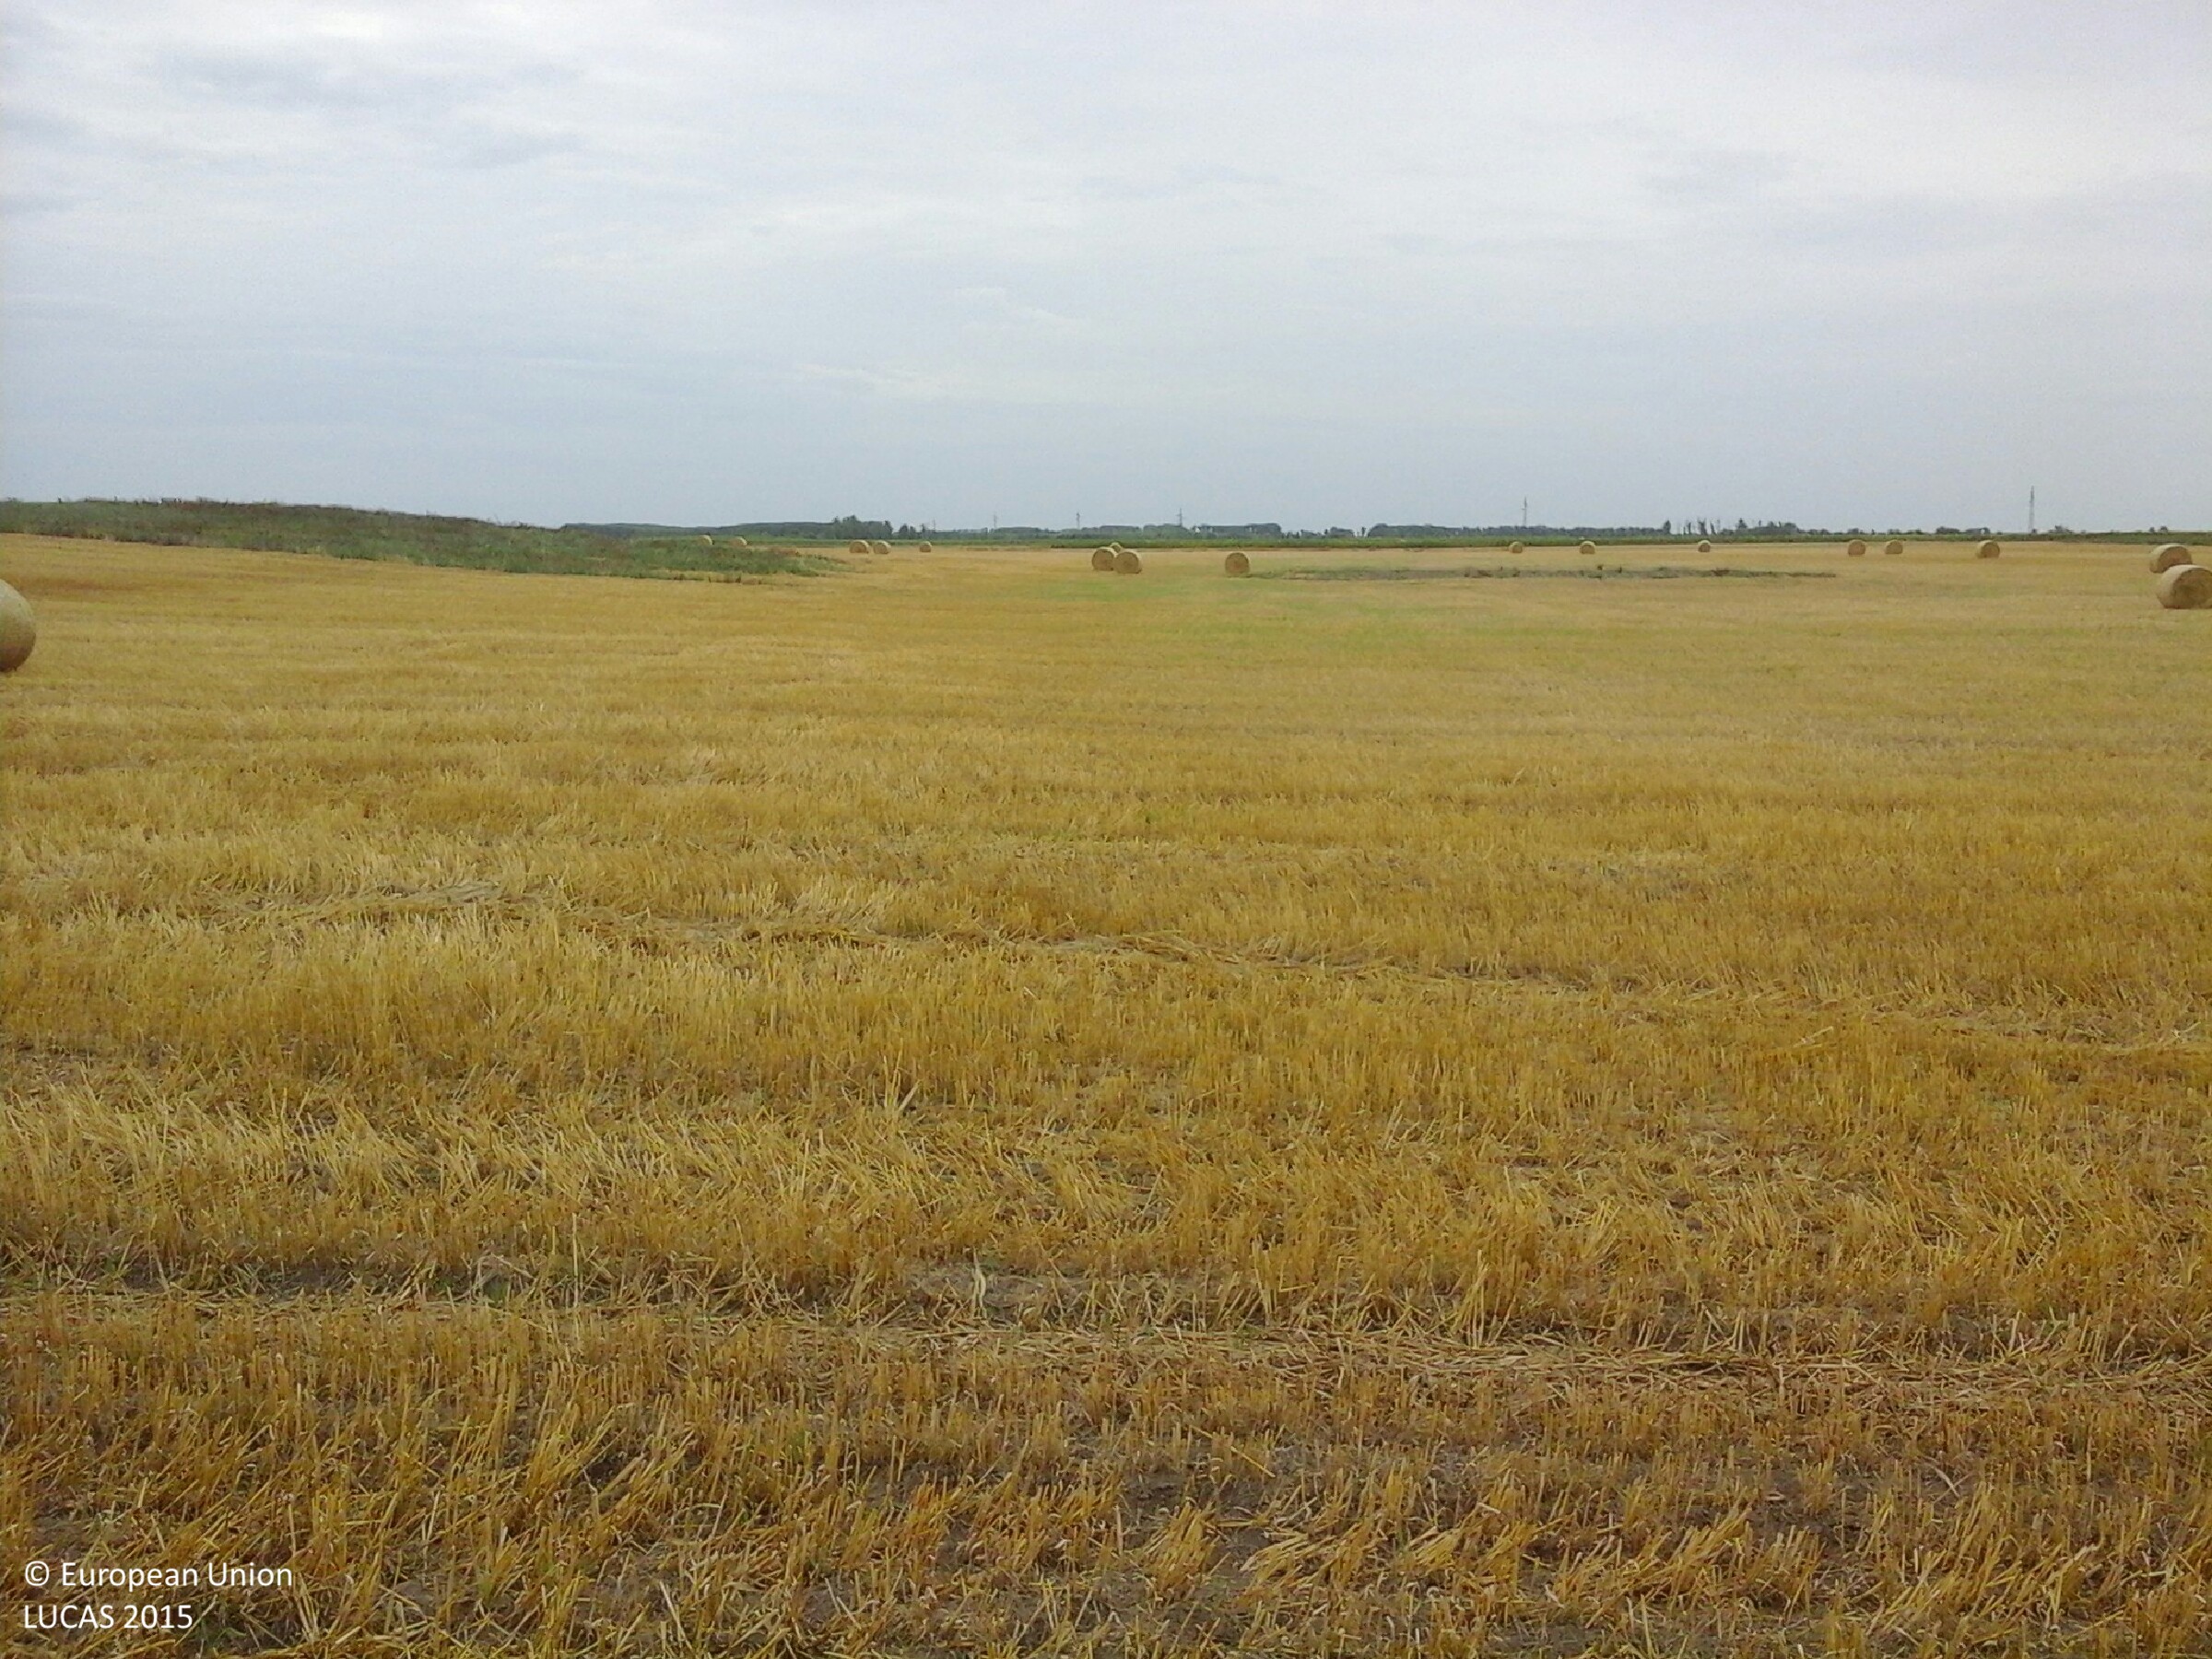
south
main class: Cropland
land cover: Common wheat
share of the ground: 25 - 50 %
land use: Agriculture (excluding fallow land and kitchen gardens)
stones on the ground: < 10 %
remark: Harvested field
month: July
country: HU
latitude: 47.4483
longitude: 20.8701
